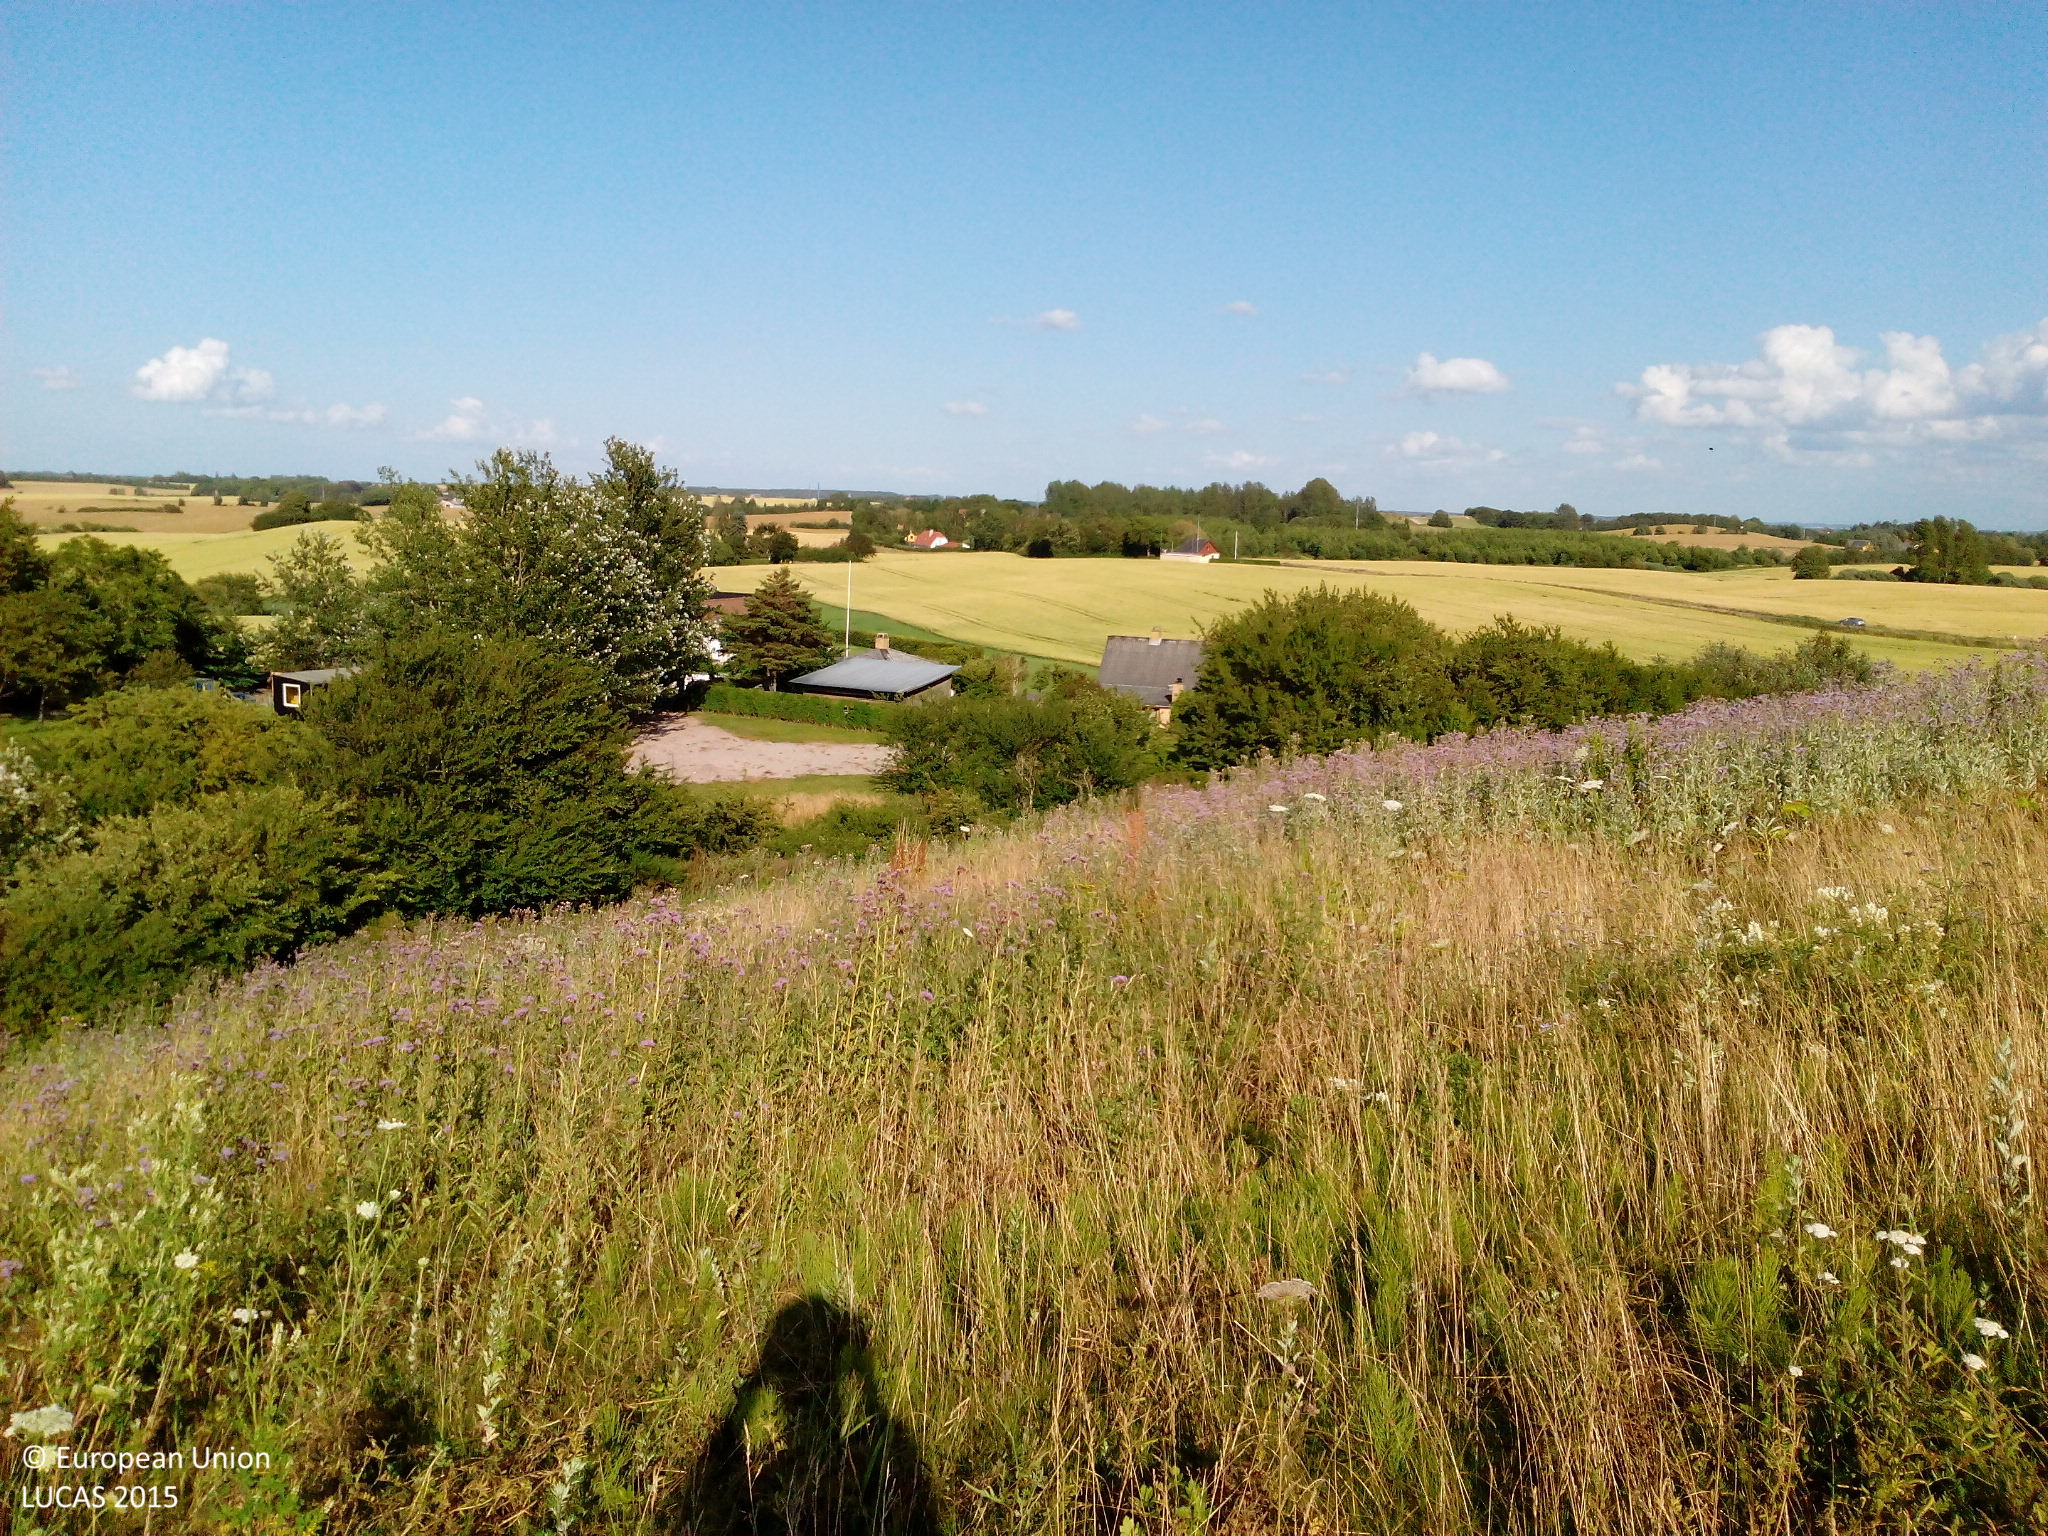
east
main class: Grassland
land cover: Spontaneously vegetated surfaces
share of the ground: > 75 %
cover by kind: herbaceous plants 100 %
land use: Fallow land
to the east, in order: Spontaneously vegetated surfaces; Broadleaved woodland; Artificial constructions in urban areas; Grassland without tree/shrub cover; Tracks; Grassland without tree/shrub cover; Artificial constructions in urban areas; Grassland without tree/shrub cover
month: July
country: DK
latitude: 55.8548
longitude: 11.5480
